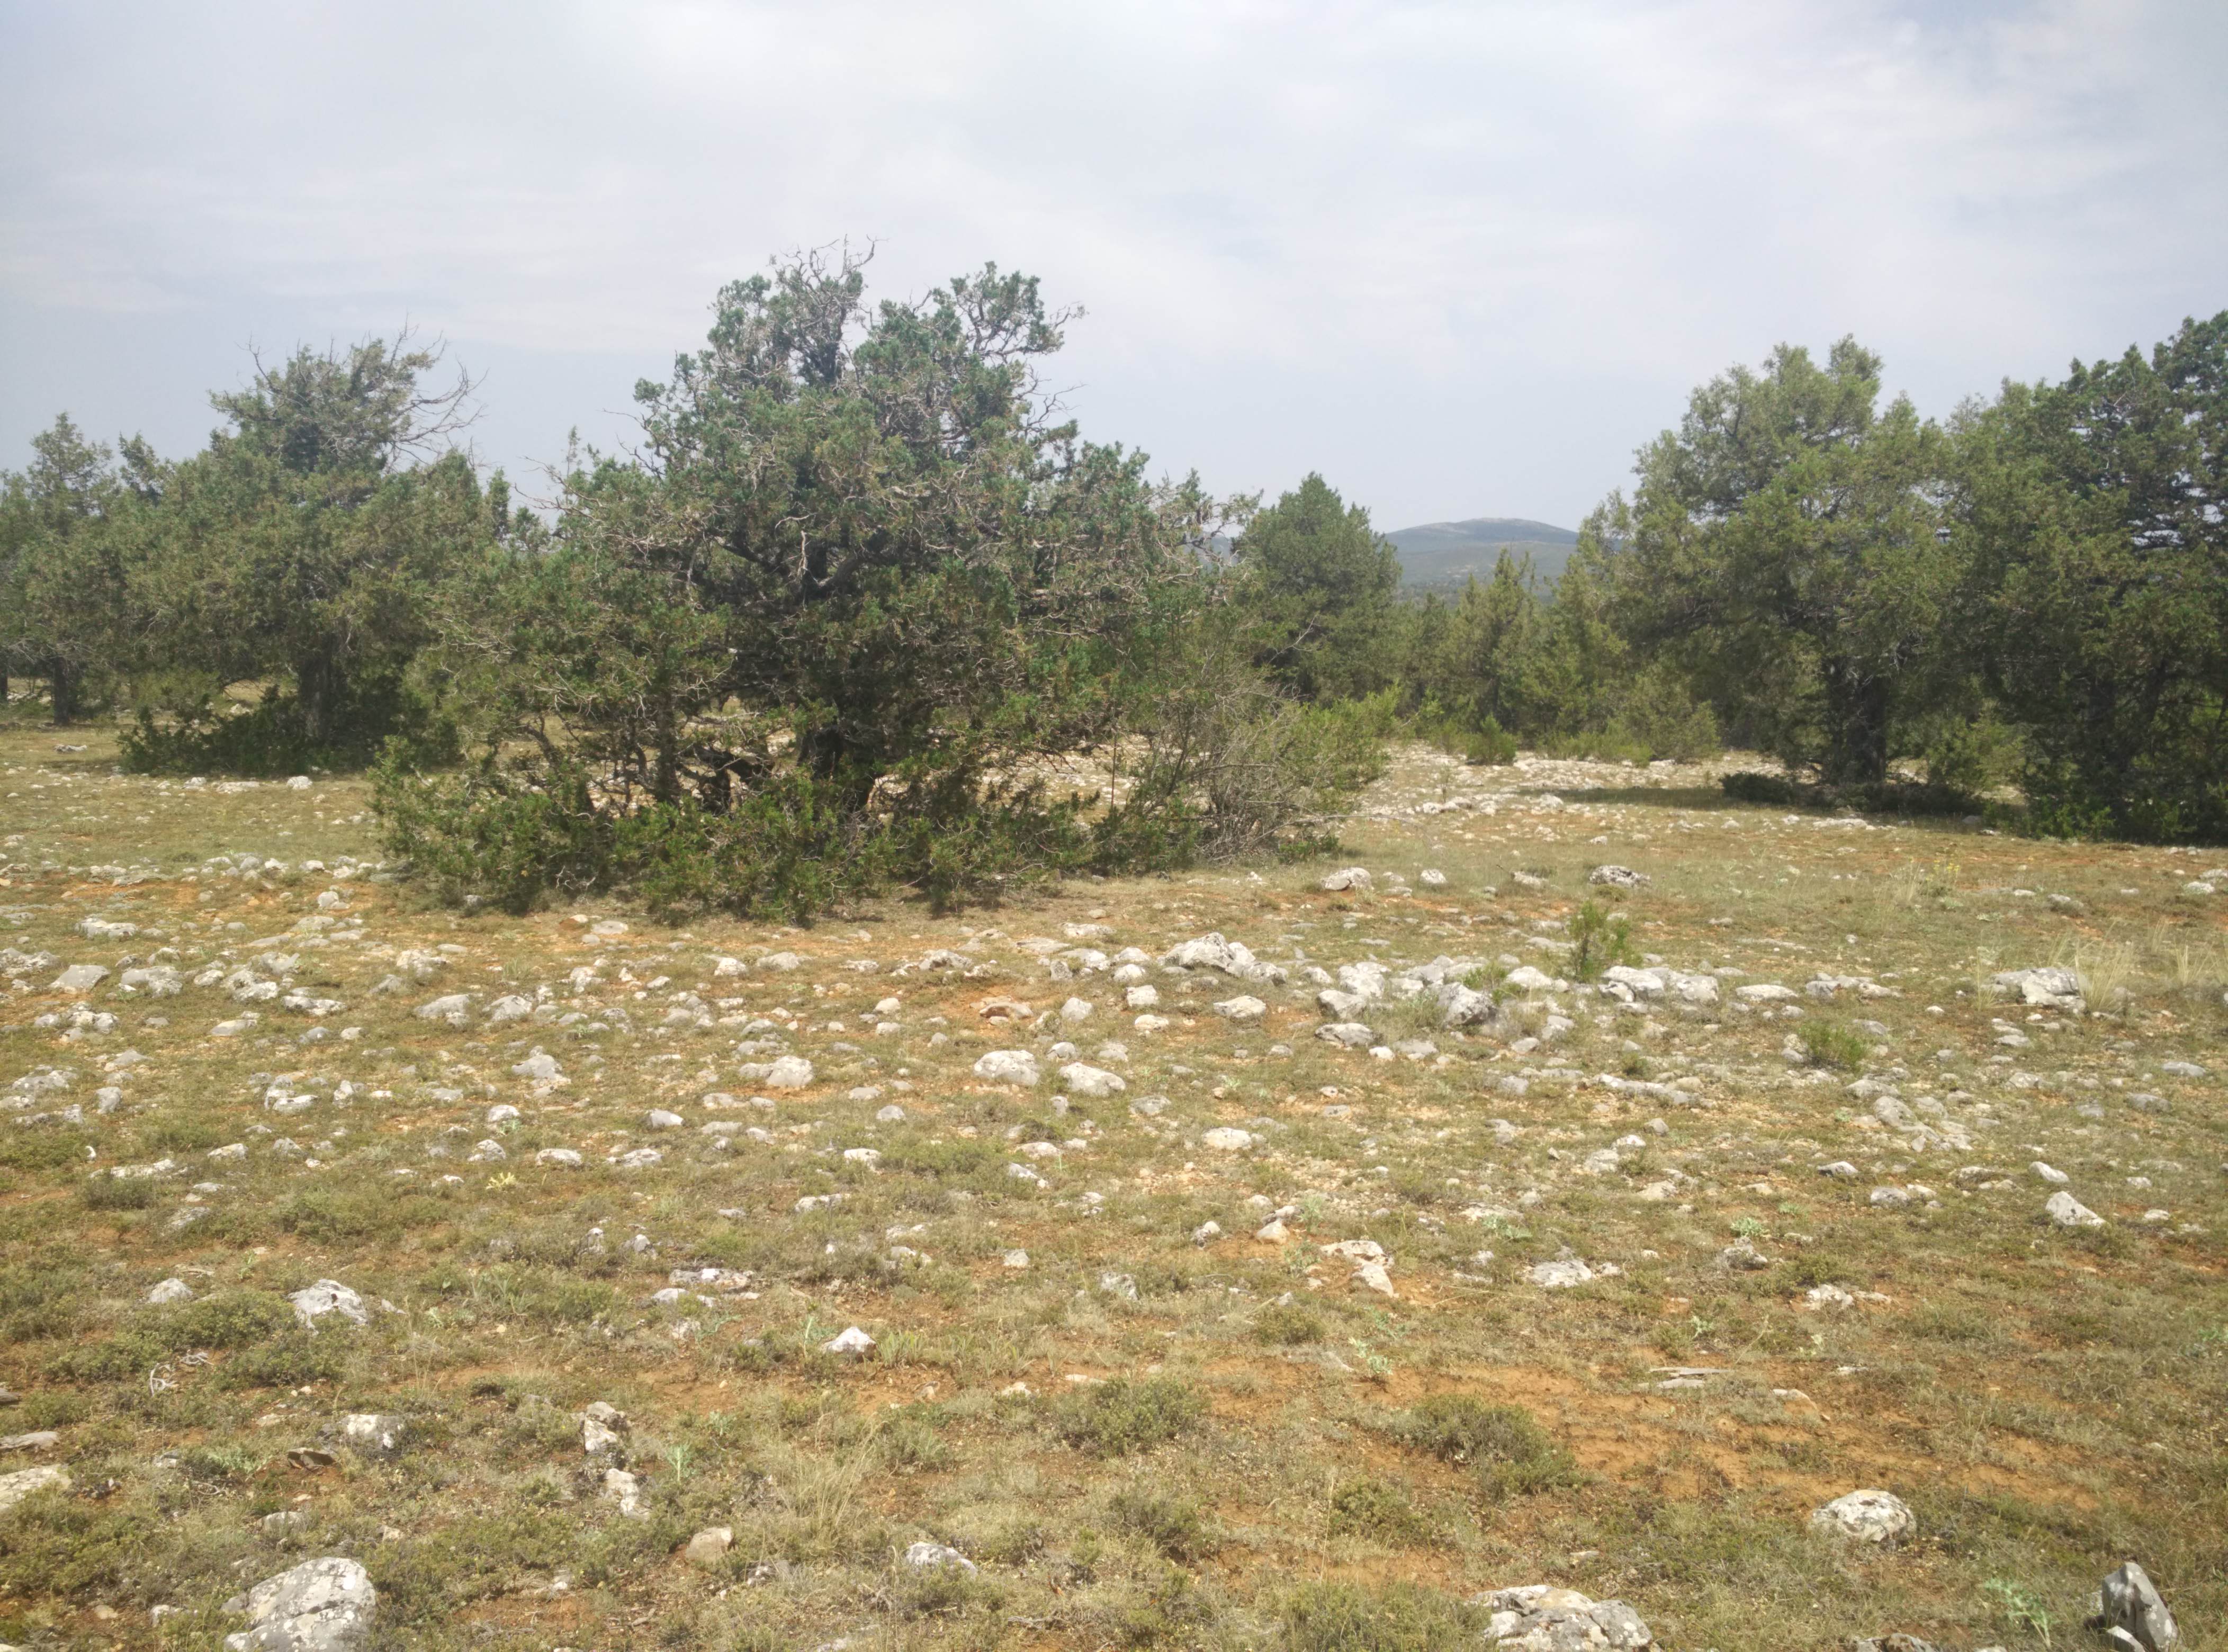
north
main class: Woodland
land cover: Other coniferous woodland
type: coniferous forest of the mediterranean region
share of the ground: 10 - 25 %
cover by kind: unconsolidated bare surface 55 %, shrubs 20 %, coniferous forest trees 15 %, herbaceous plants 5 %, lichens and mosses 5 %
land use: Semi-natural and natural areas not in use
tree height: > 5 m
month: July
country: ES
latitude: 40.8948
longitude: -2.0242
